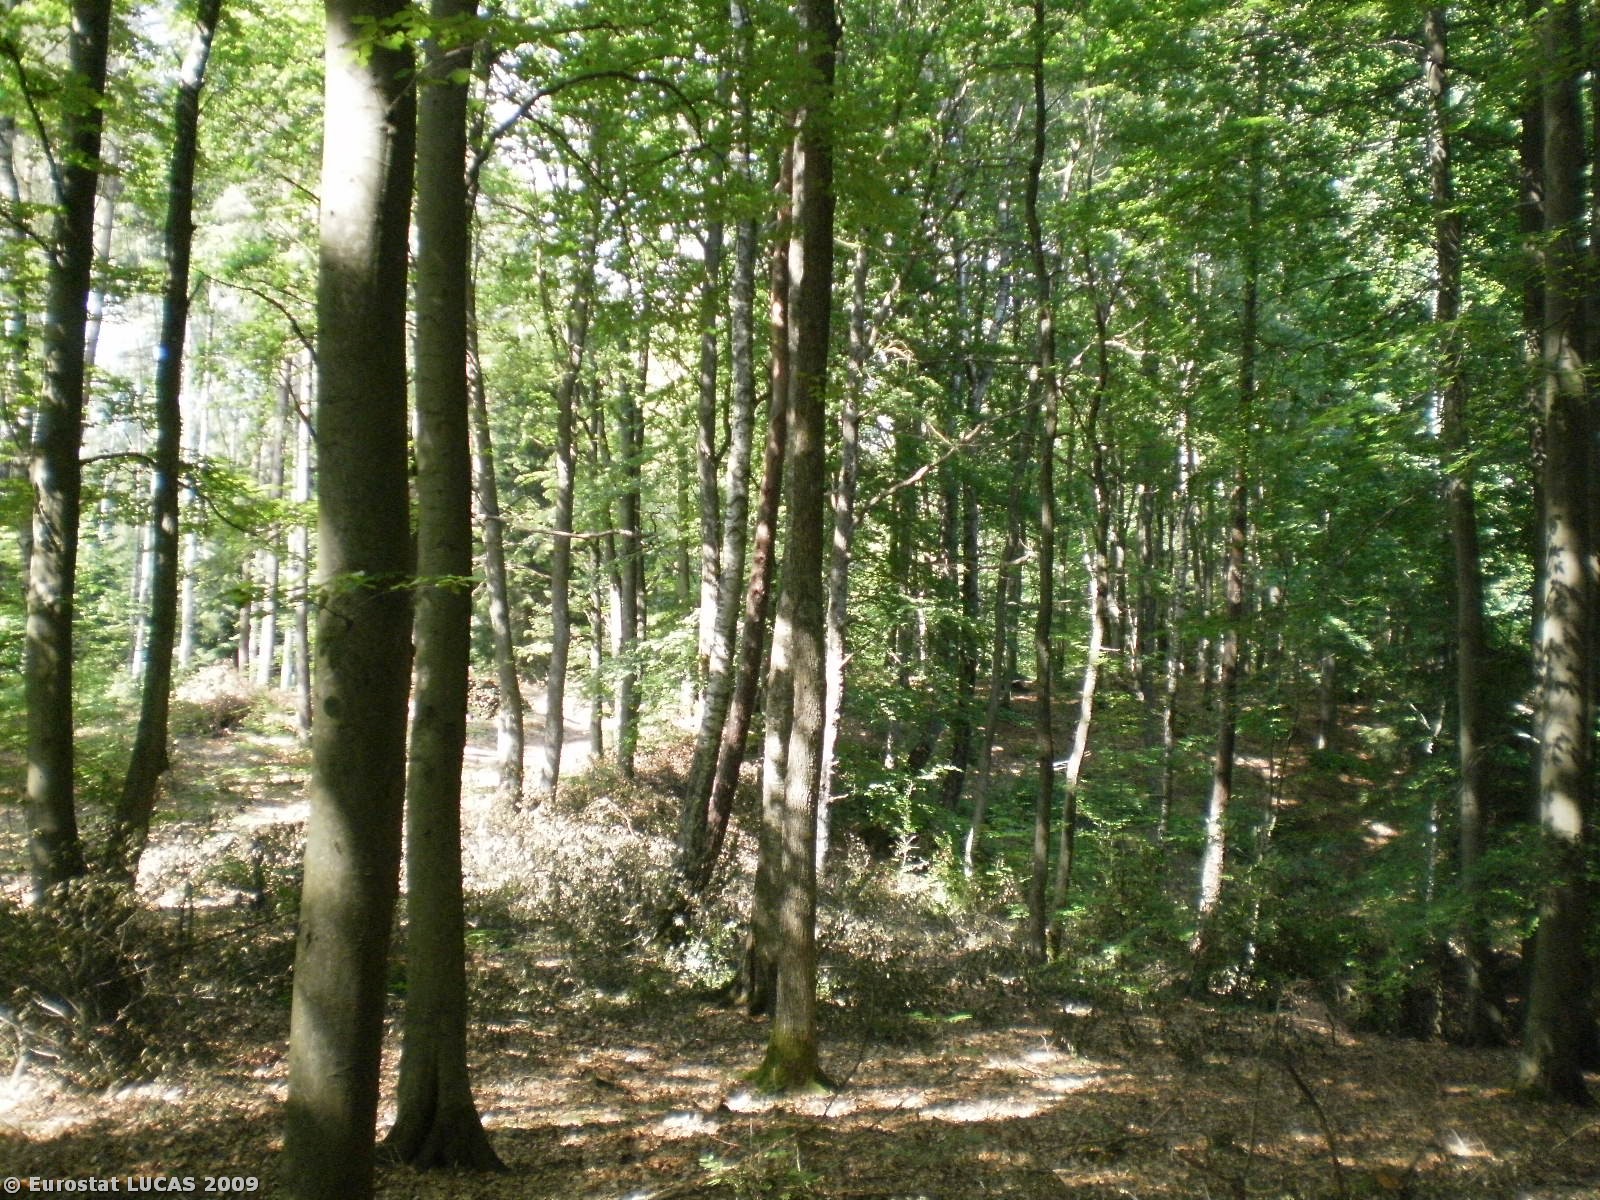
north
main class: Woodland
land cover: Mixed woodland
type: hemiboreal forest and nemoral coniferous forest and mixed broadleaved-coniferous forest
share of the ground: > 75 %
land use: Forestry
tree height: > 5 m
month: July
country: PL
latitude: 54.1055
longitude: 17.2439
